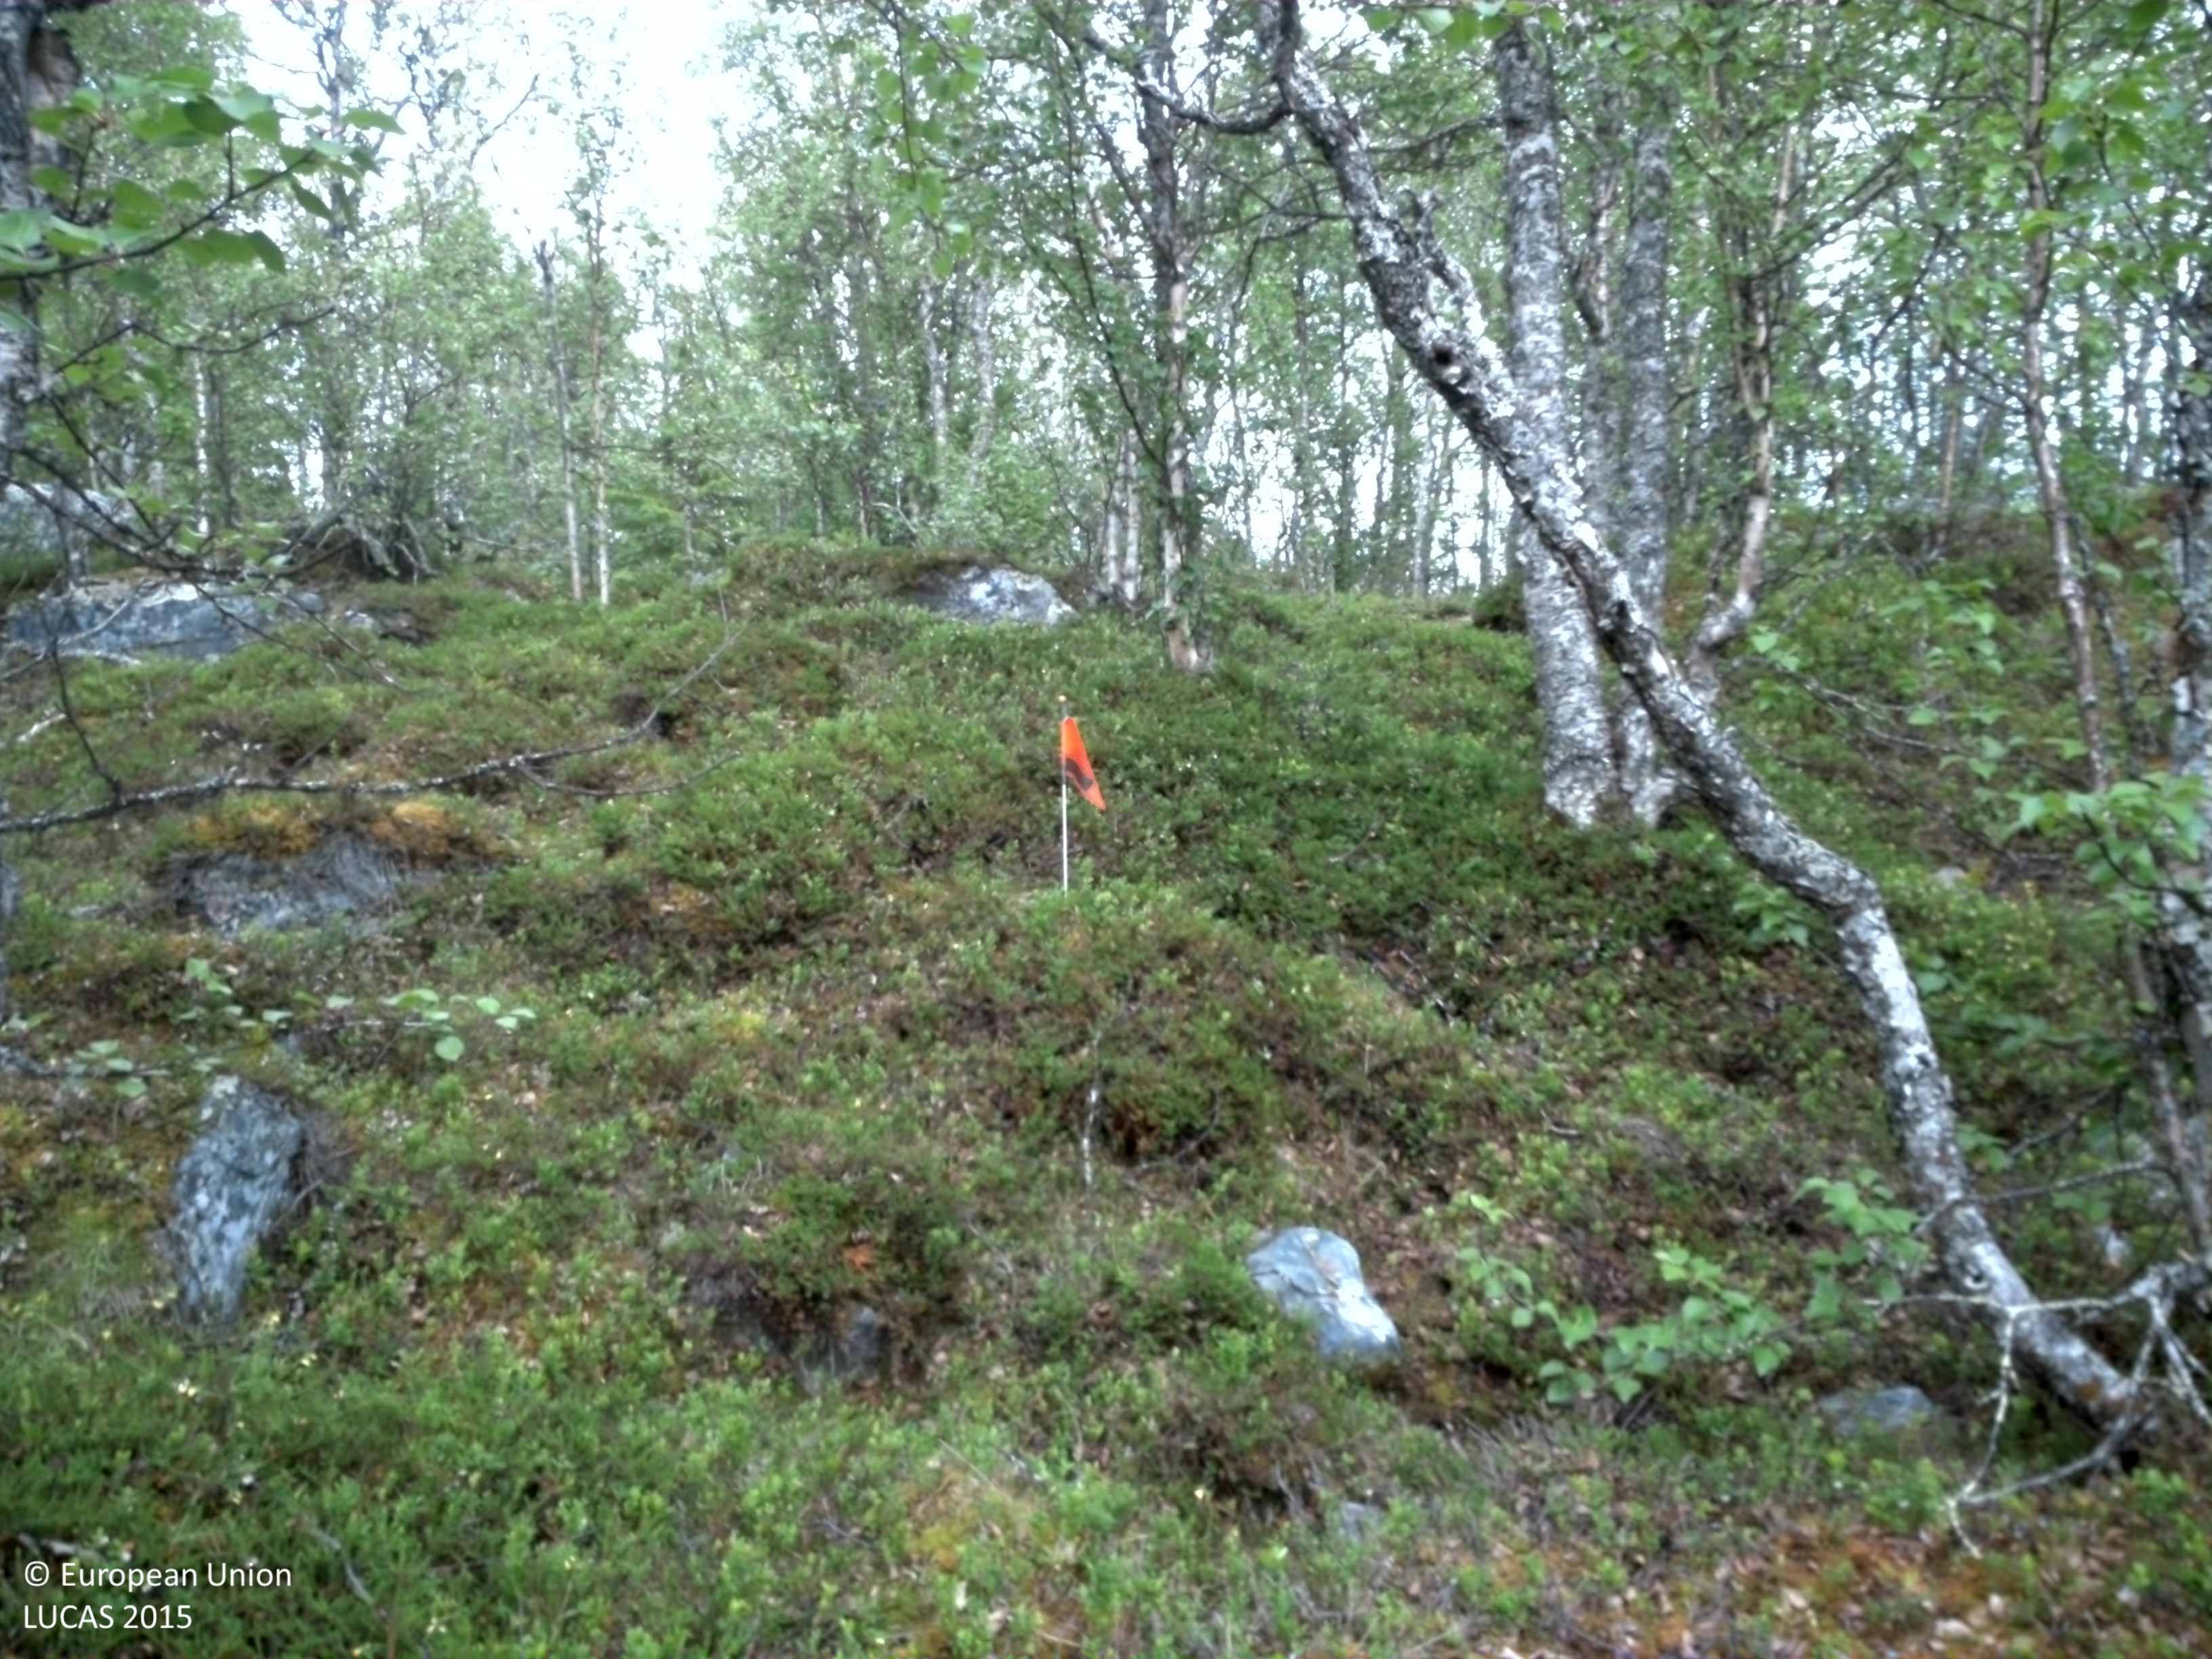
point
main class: Woodland
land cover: Broadleaved woodland
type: hemiboreal forest and nemoral coniferous forest and mixed broadleaved-coniferous forest
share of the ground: 25 - 50 %
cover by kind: shrubs 55 %, broadleaved forest trees 30 %, lichens and mosses 10 %, coniferous forest trees 5 %
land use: Amenities, museums, leisure
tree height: > 5 m
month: July
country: SE
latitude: 65.5485
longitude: 16.1328
